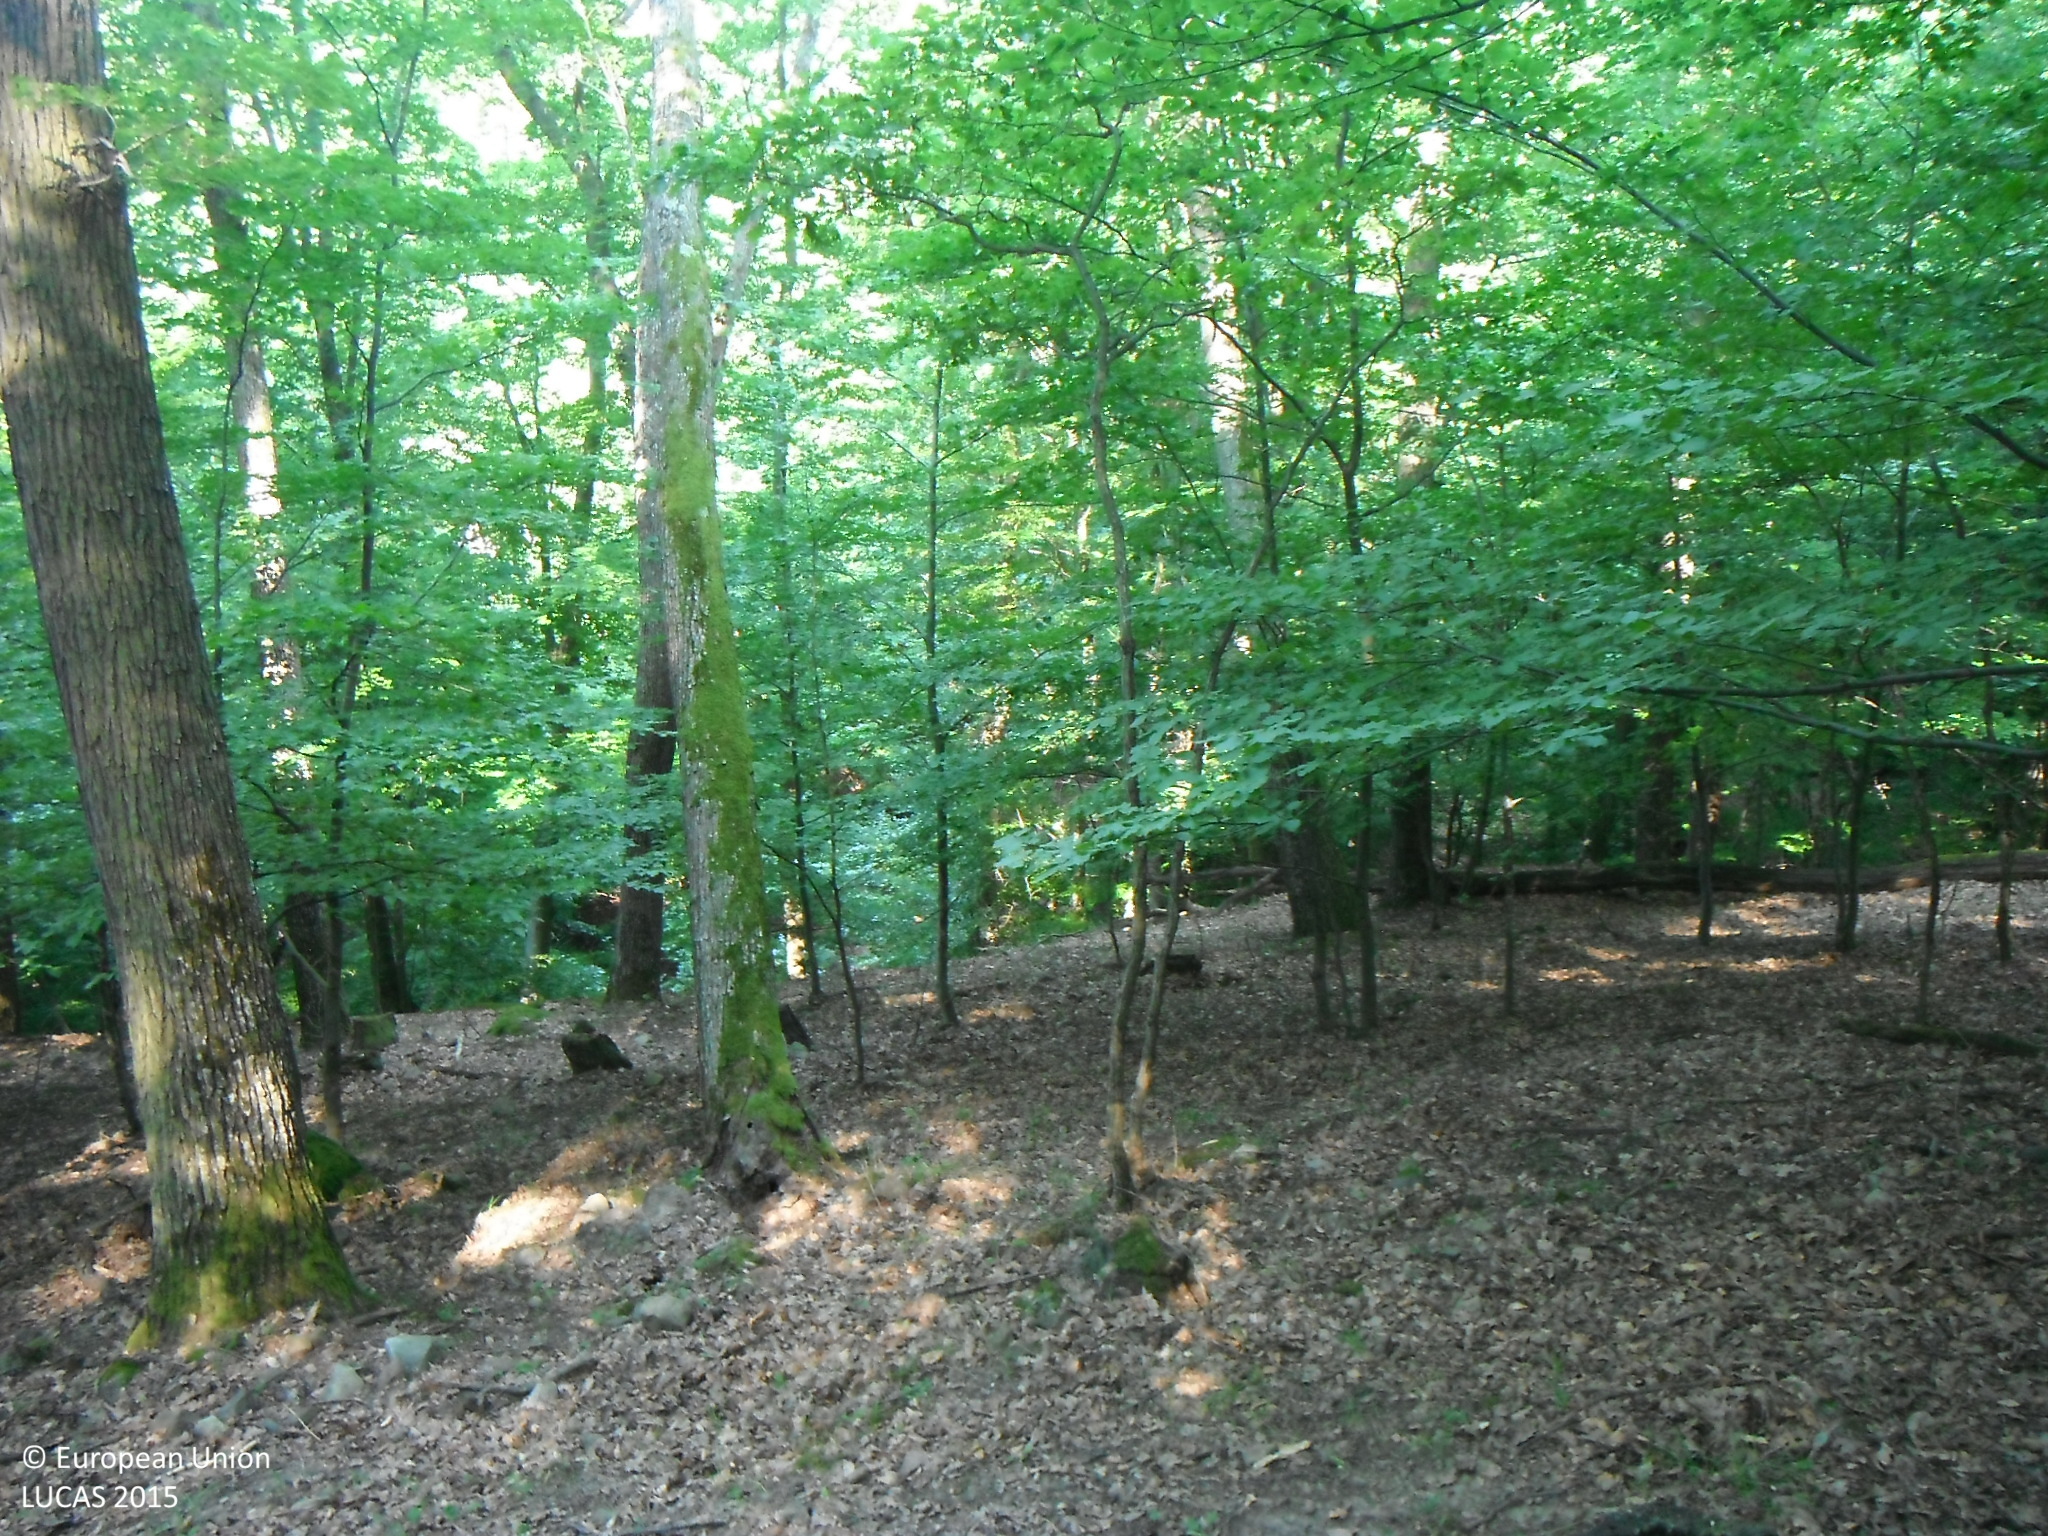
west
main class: Woodland
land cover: Broadleaved woodland
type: acidophilous oak and oak-birch forest
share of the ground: > 75 %
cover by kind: broadleaved forest trees 95 %, herbaceous plants 5 %
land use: Forestry
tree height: > 5 m
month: July
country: SK
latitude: 48.1994
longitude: 19.2109
